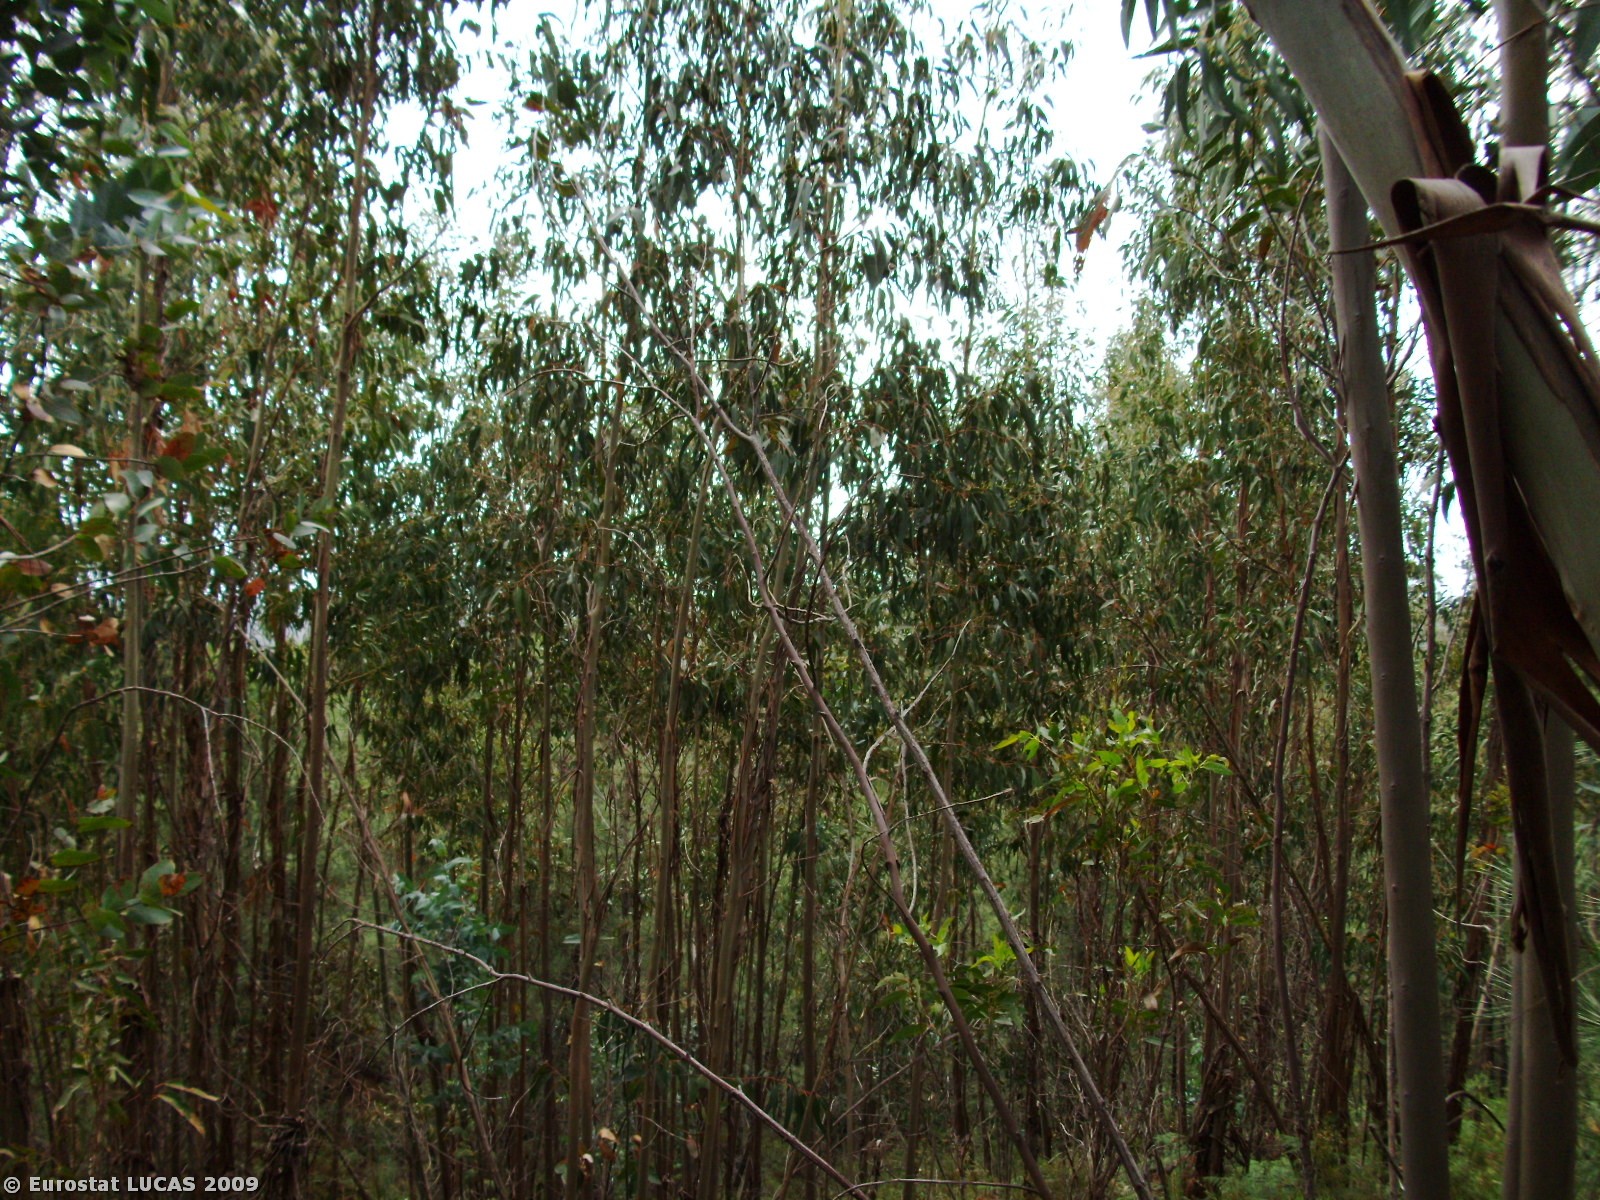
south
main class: Woodland
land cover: Broadleaved woodland
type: plantations and self-sown exotic forest
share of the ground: > 75 %
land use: Forestry
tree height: > 5 m
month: June
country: PT
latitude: 39.9663
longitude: -8.2322
